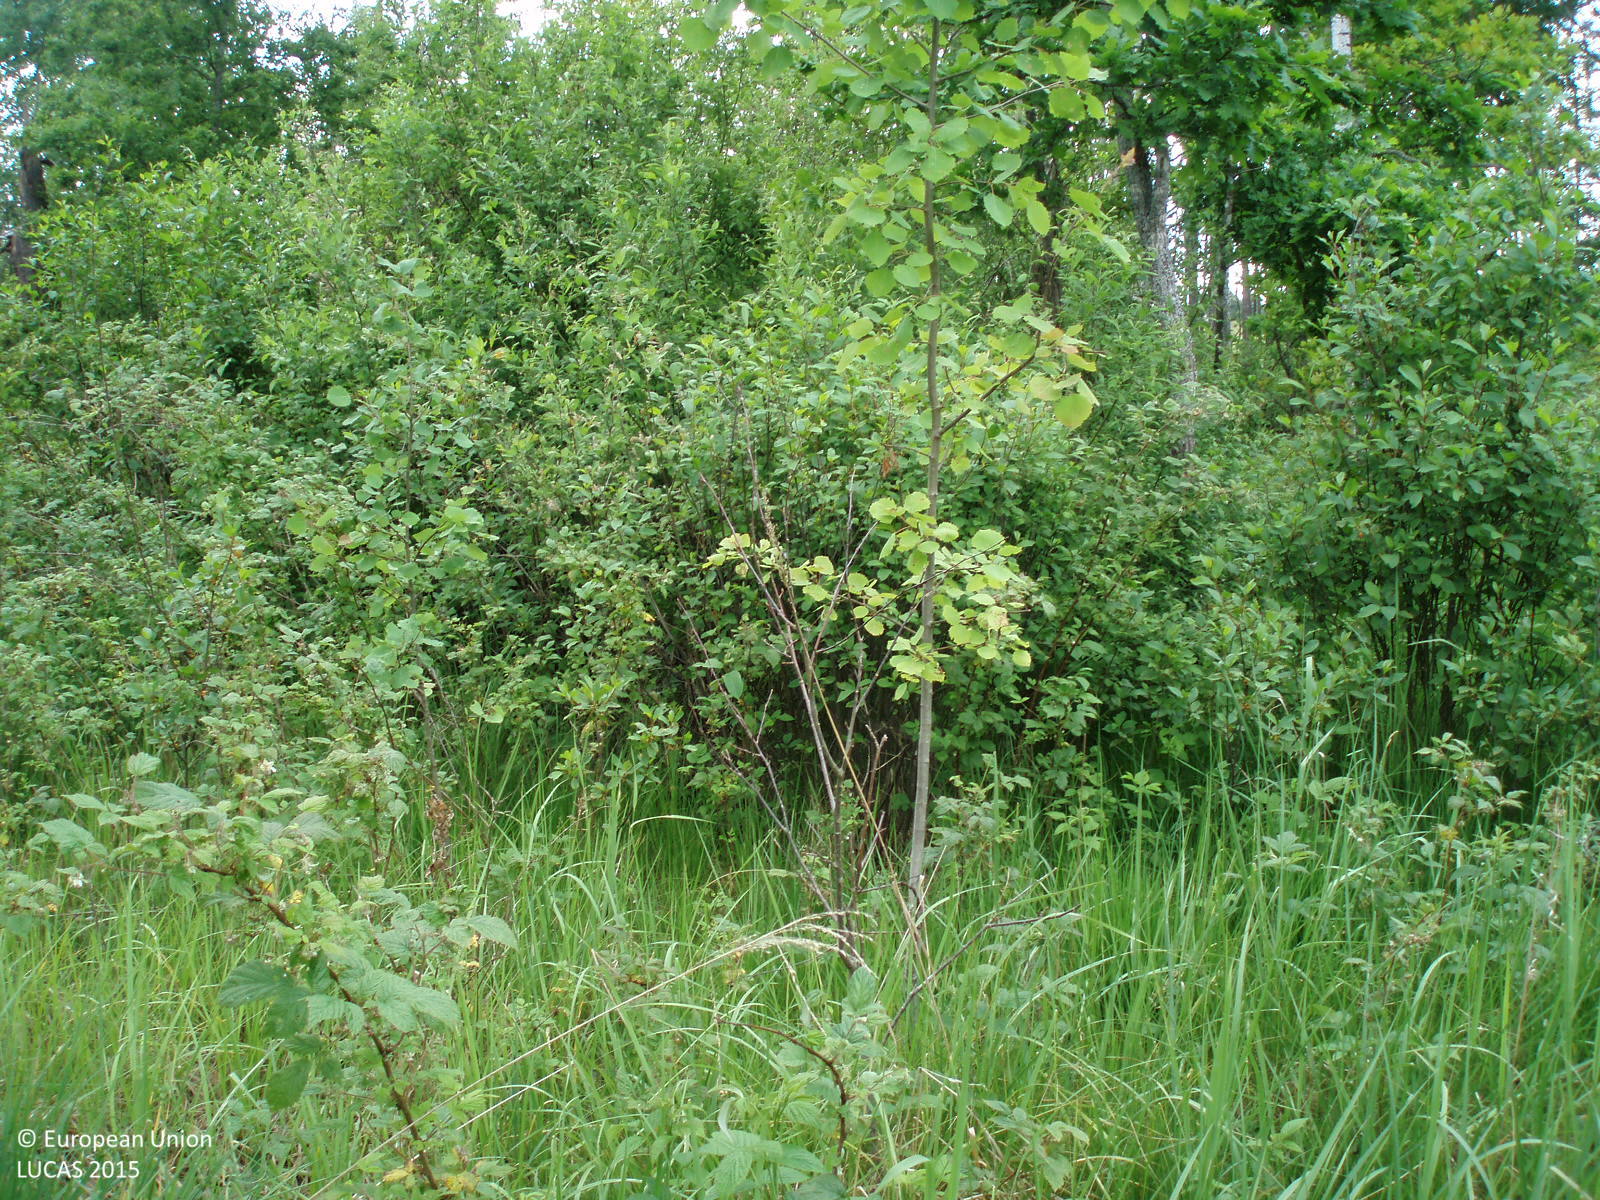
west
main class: Woodland
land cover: Broadleaved woodland
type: non-riverine alder, birch or aspen forest
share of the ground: 25 - 50 %
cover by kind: shrubs 50 %, broadleaved forest trees 30 %, herbaceous plants 20 %
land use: Forestry
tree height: < 5 m
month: June
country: LT
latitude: 55.0801
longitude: 22.5157
